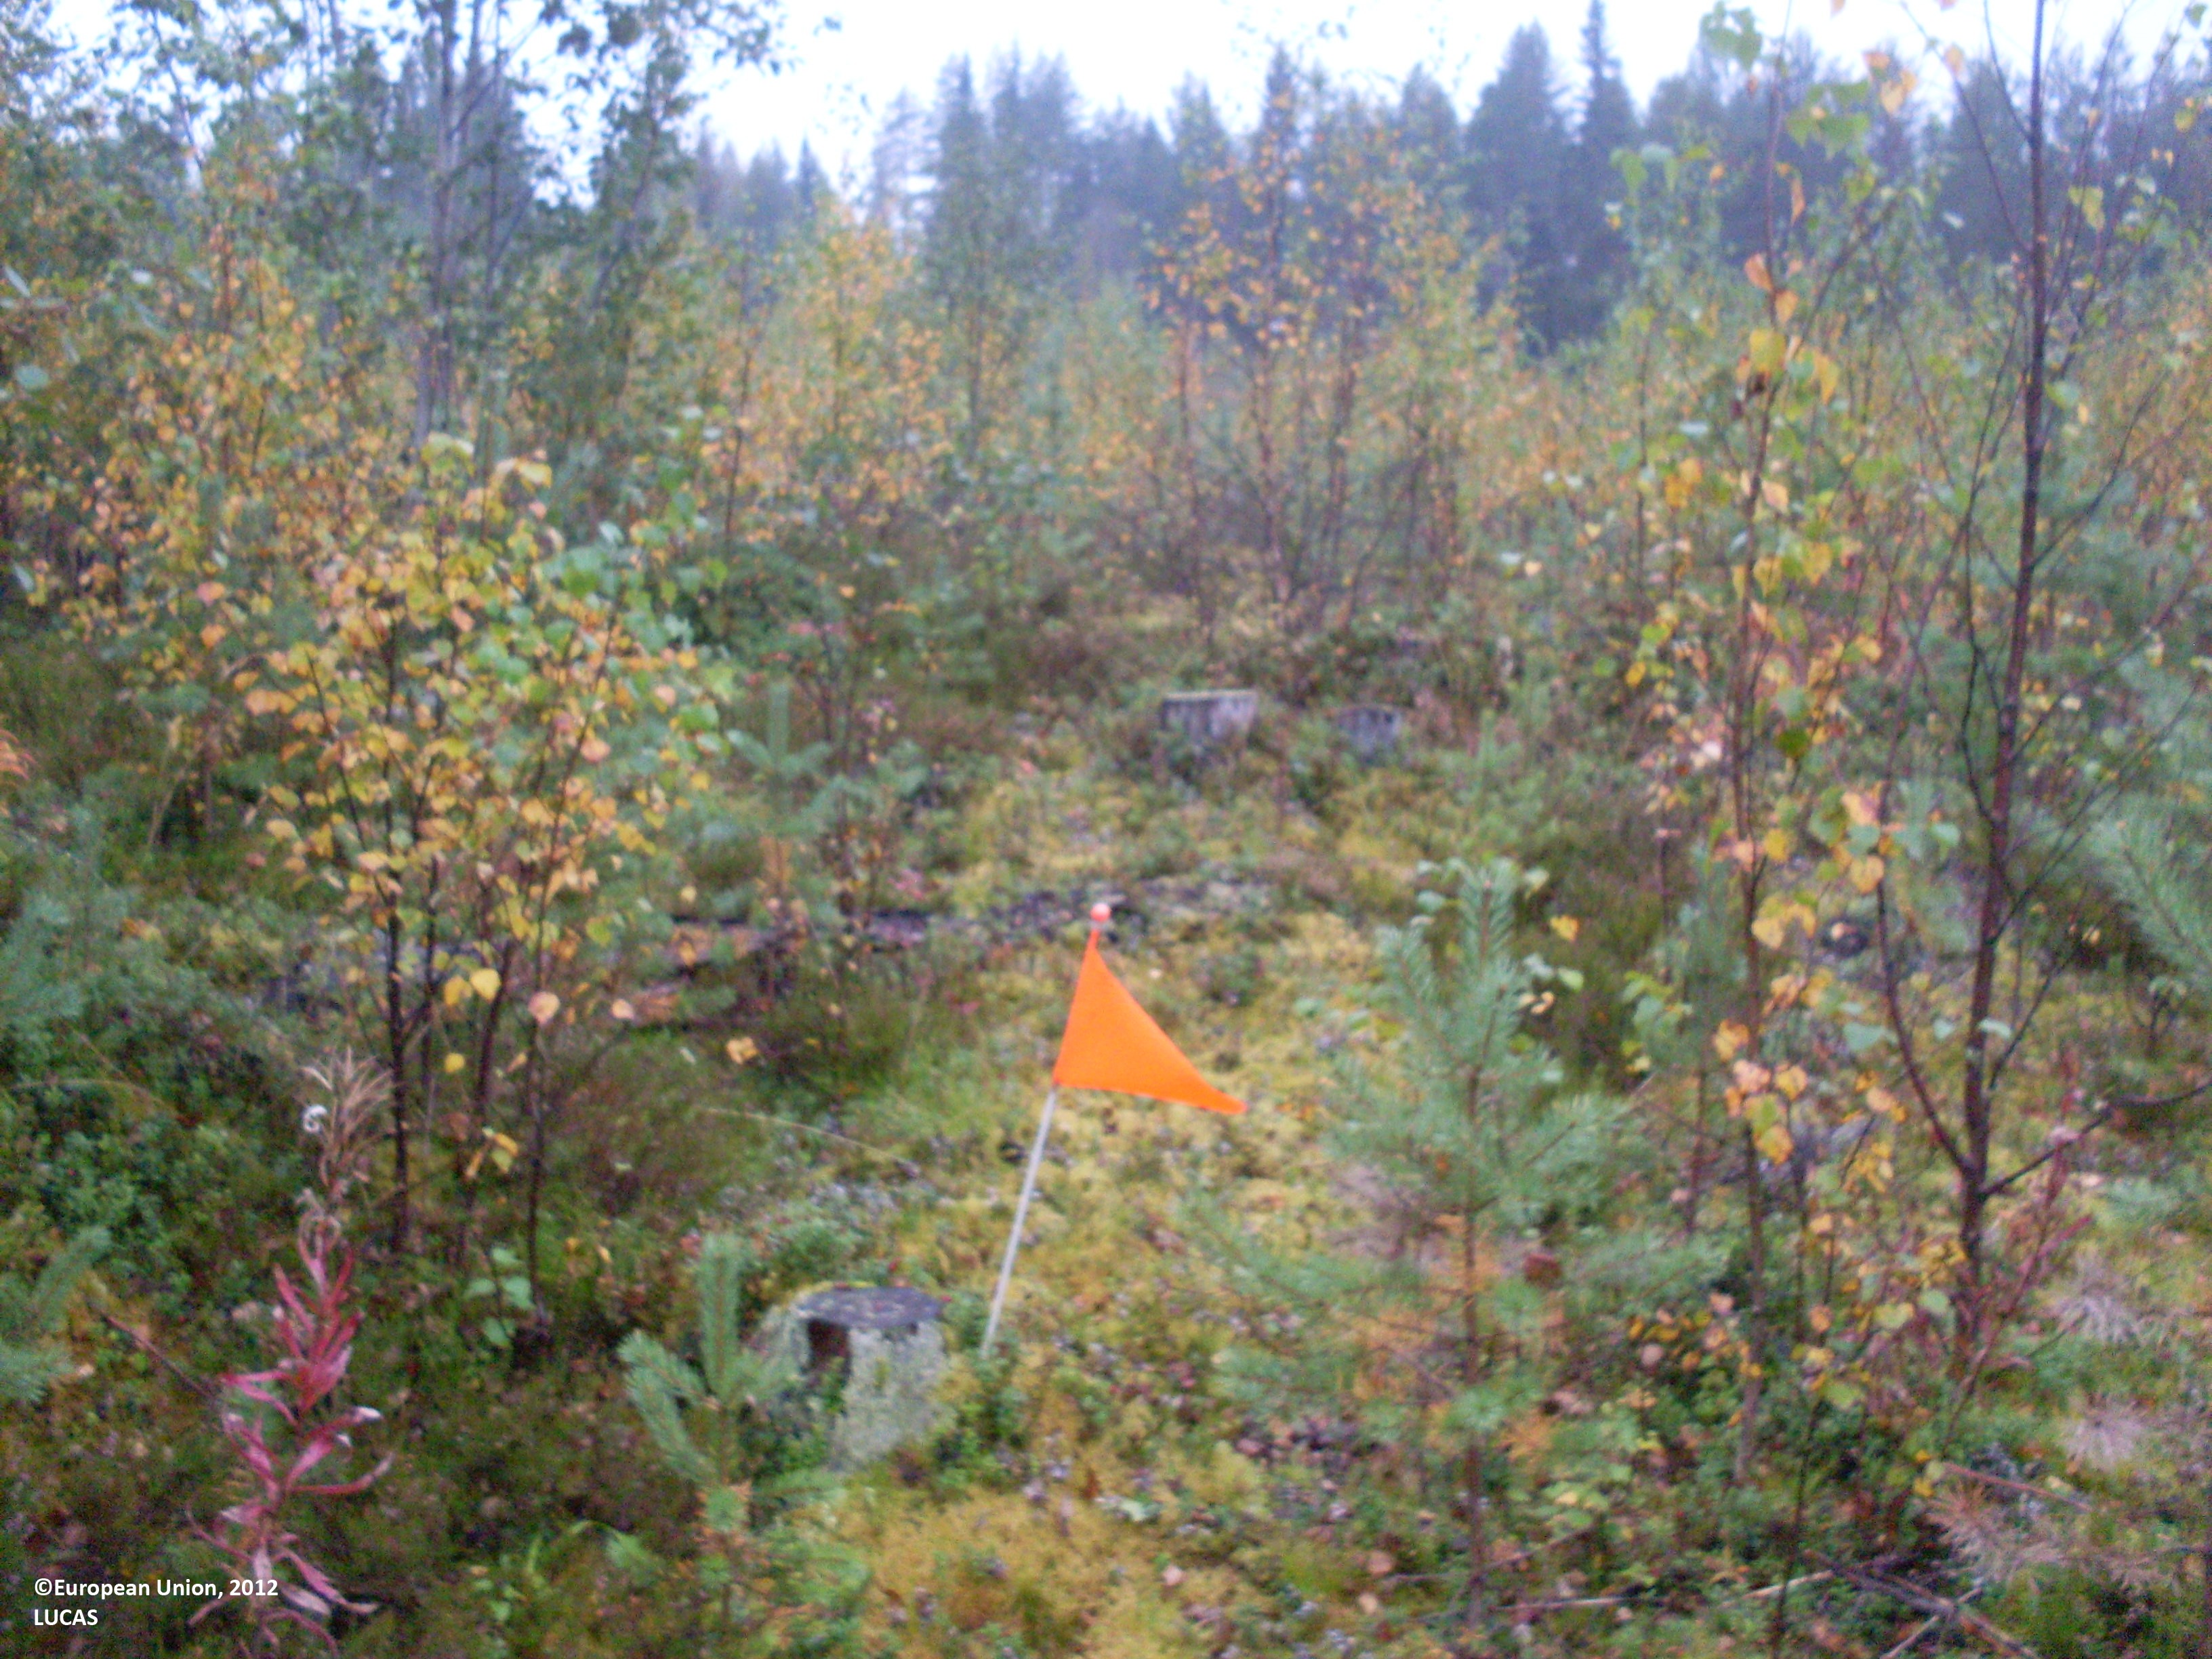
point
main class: Woodland
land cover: Pine dominated mixed woodland
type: boreal forest
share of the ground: 10 - 25 %
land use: Forestry
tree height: < 5 m
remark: Nursery
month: September
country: FI
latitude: 64.1670
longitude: 28.8489
